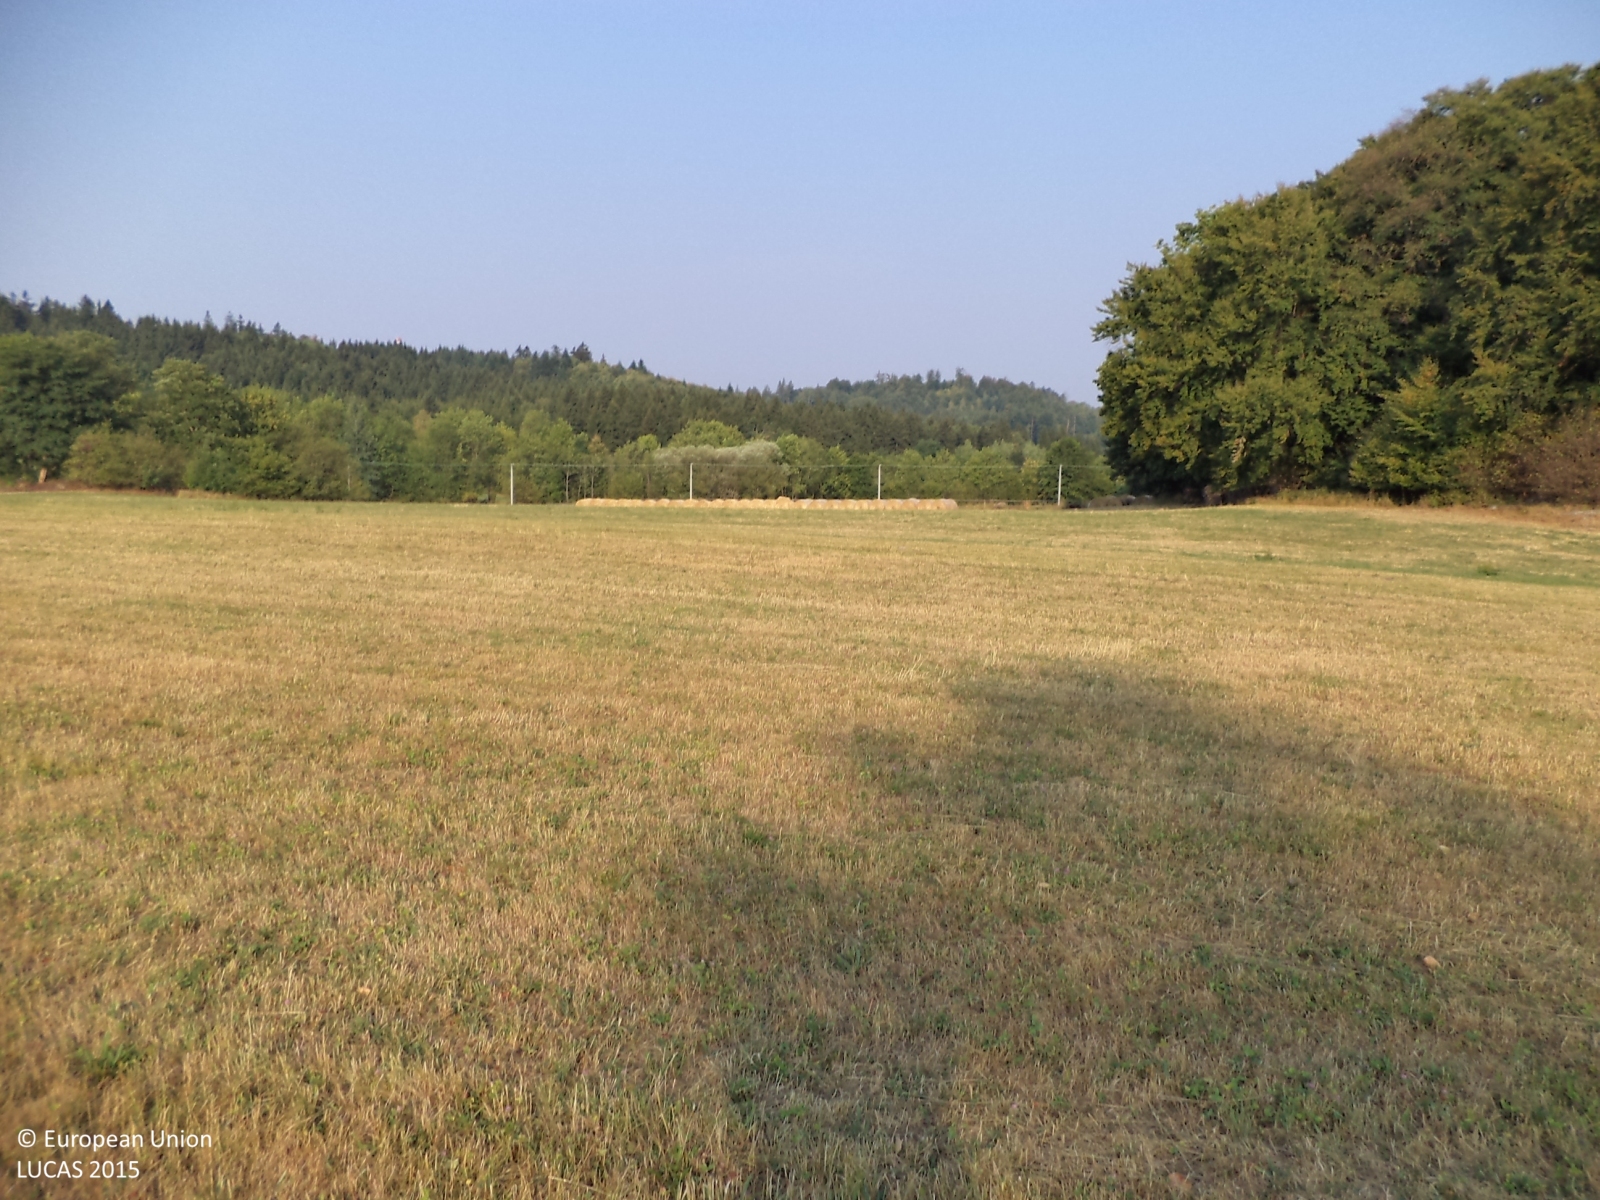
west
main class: Grassland
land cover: Grassland without tree/shrub cover
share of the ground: > 75 %
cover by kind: herbaceous plants 100 %
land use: Agriculture (excluding fallow land and kitchen gardens)
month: August
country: CZ
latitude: 49.5396
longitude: 14.4373
